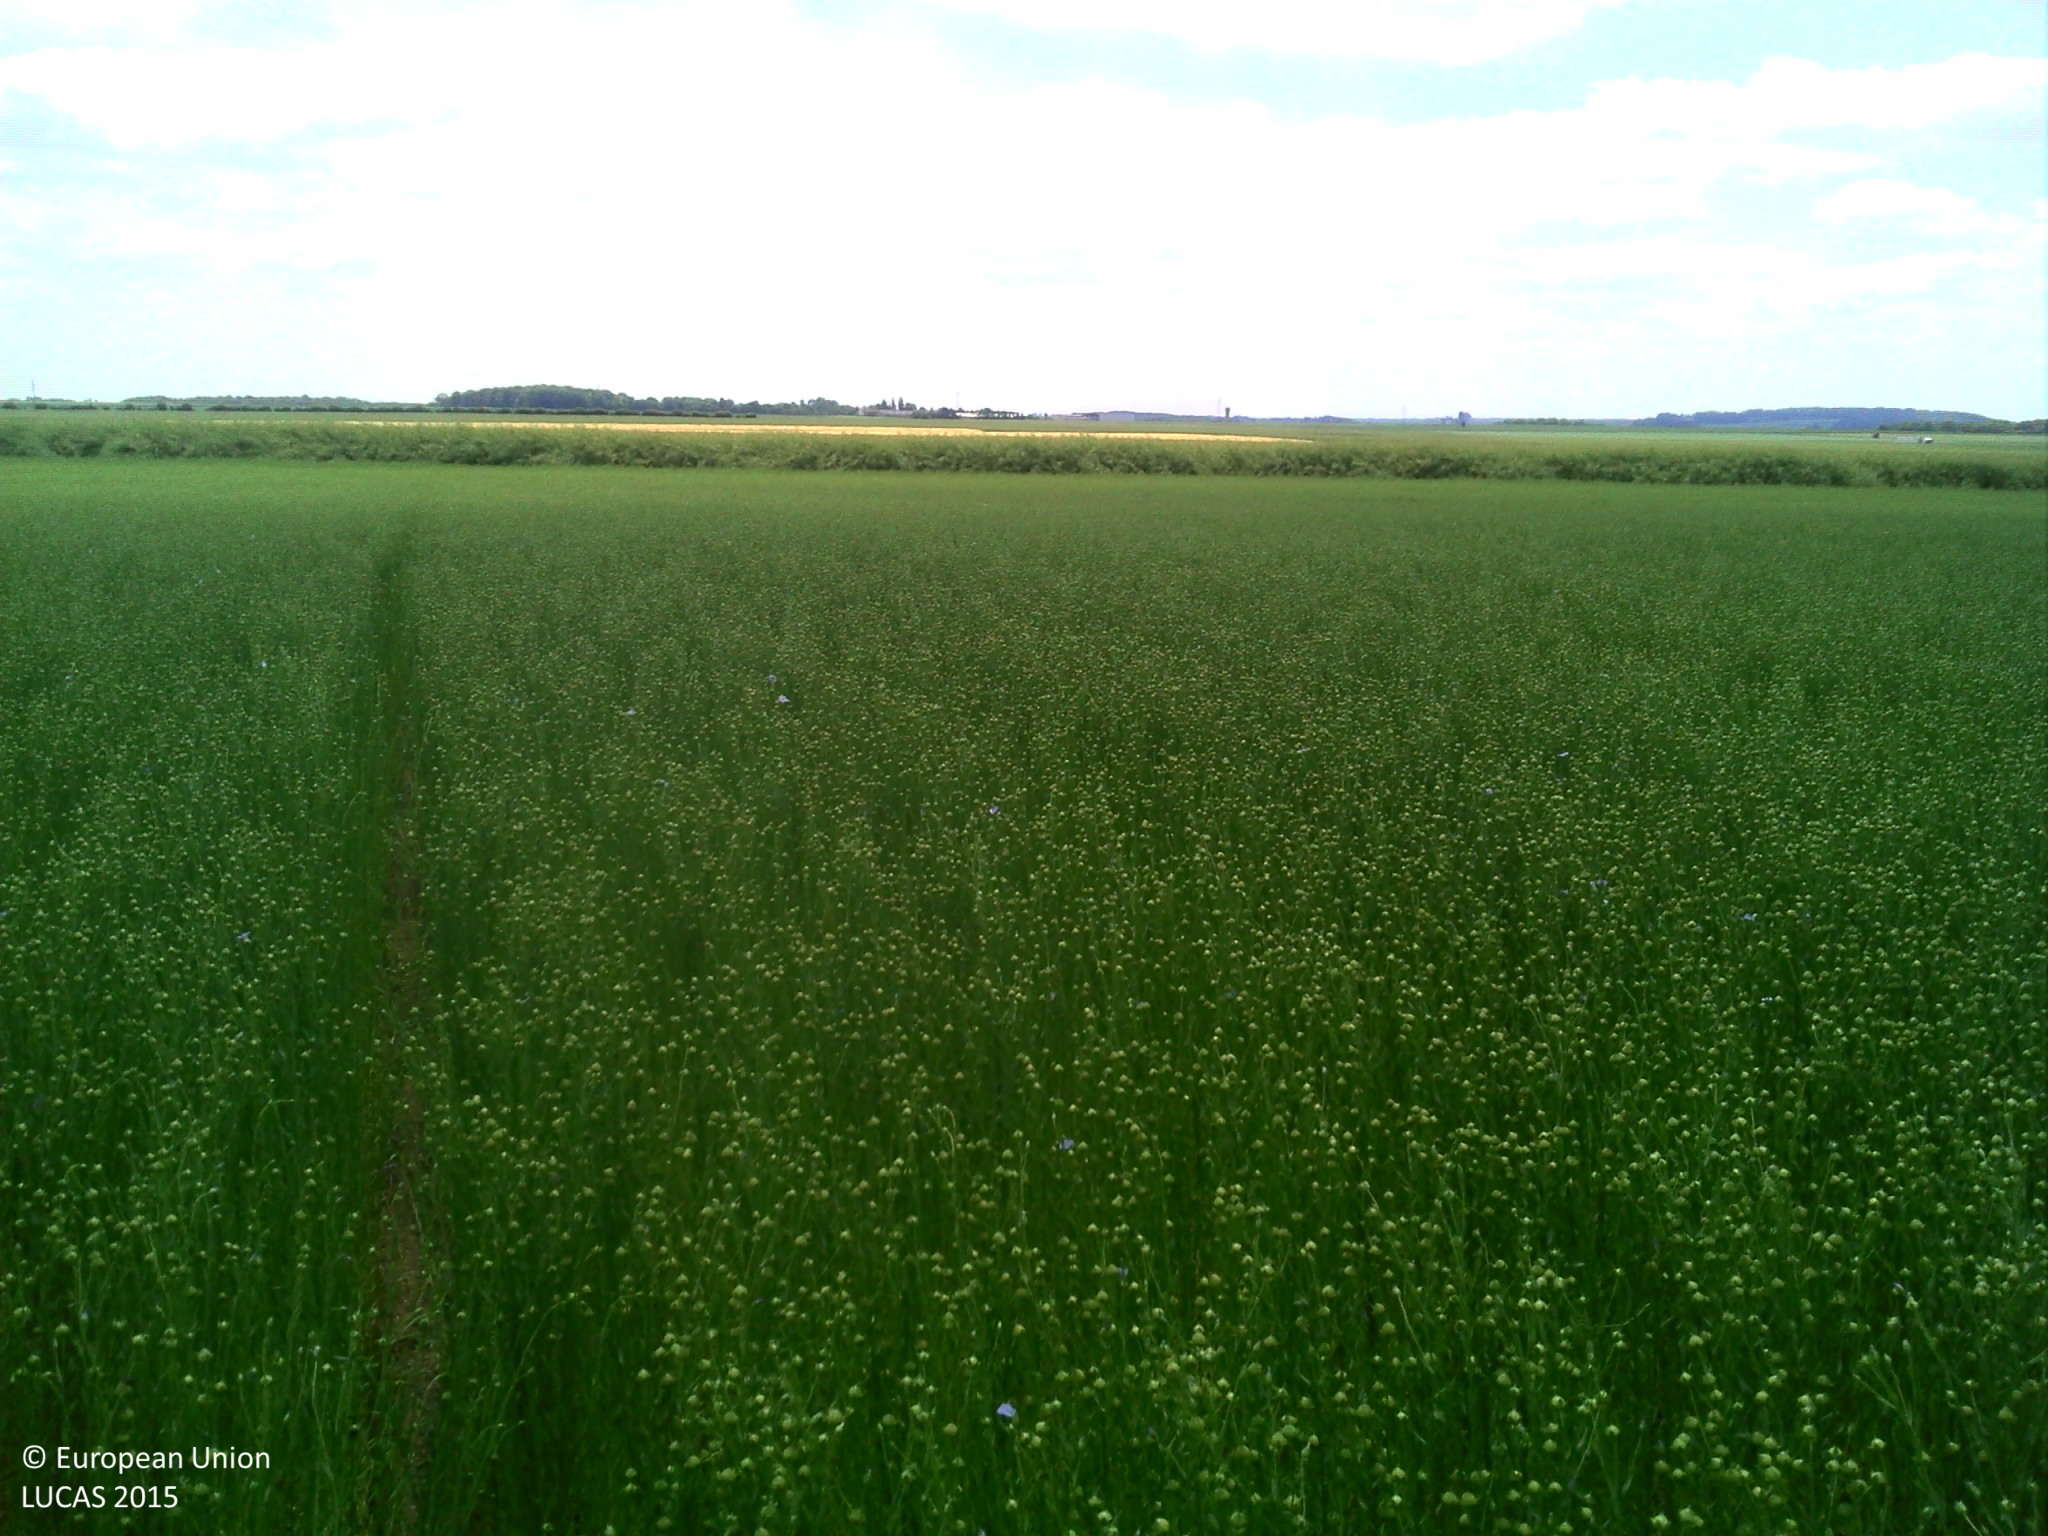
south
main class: Cropland
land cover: Other fibre and oleaginous crops
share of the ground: > 75 %
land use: Agriculture (excluding fallow land and kitchen gardens)
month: June
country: FR
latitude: 49.6835
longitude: 2.4895
